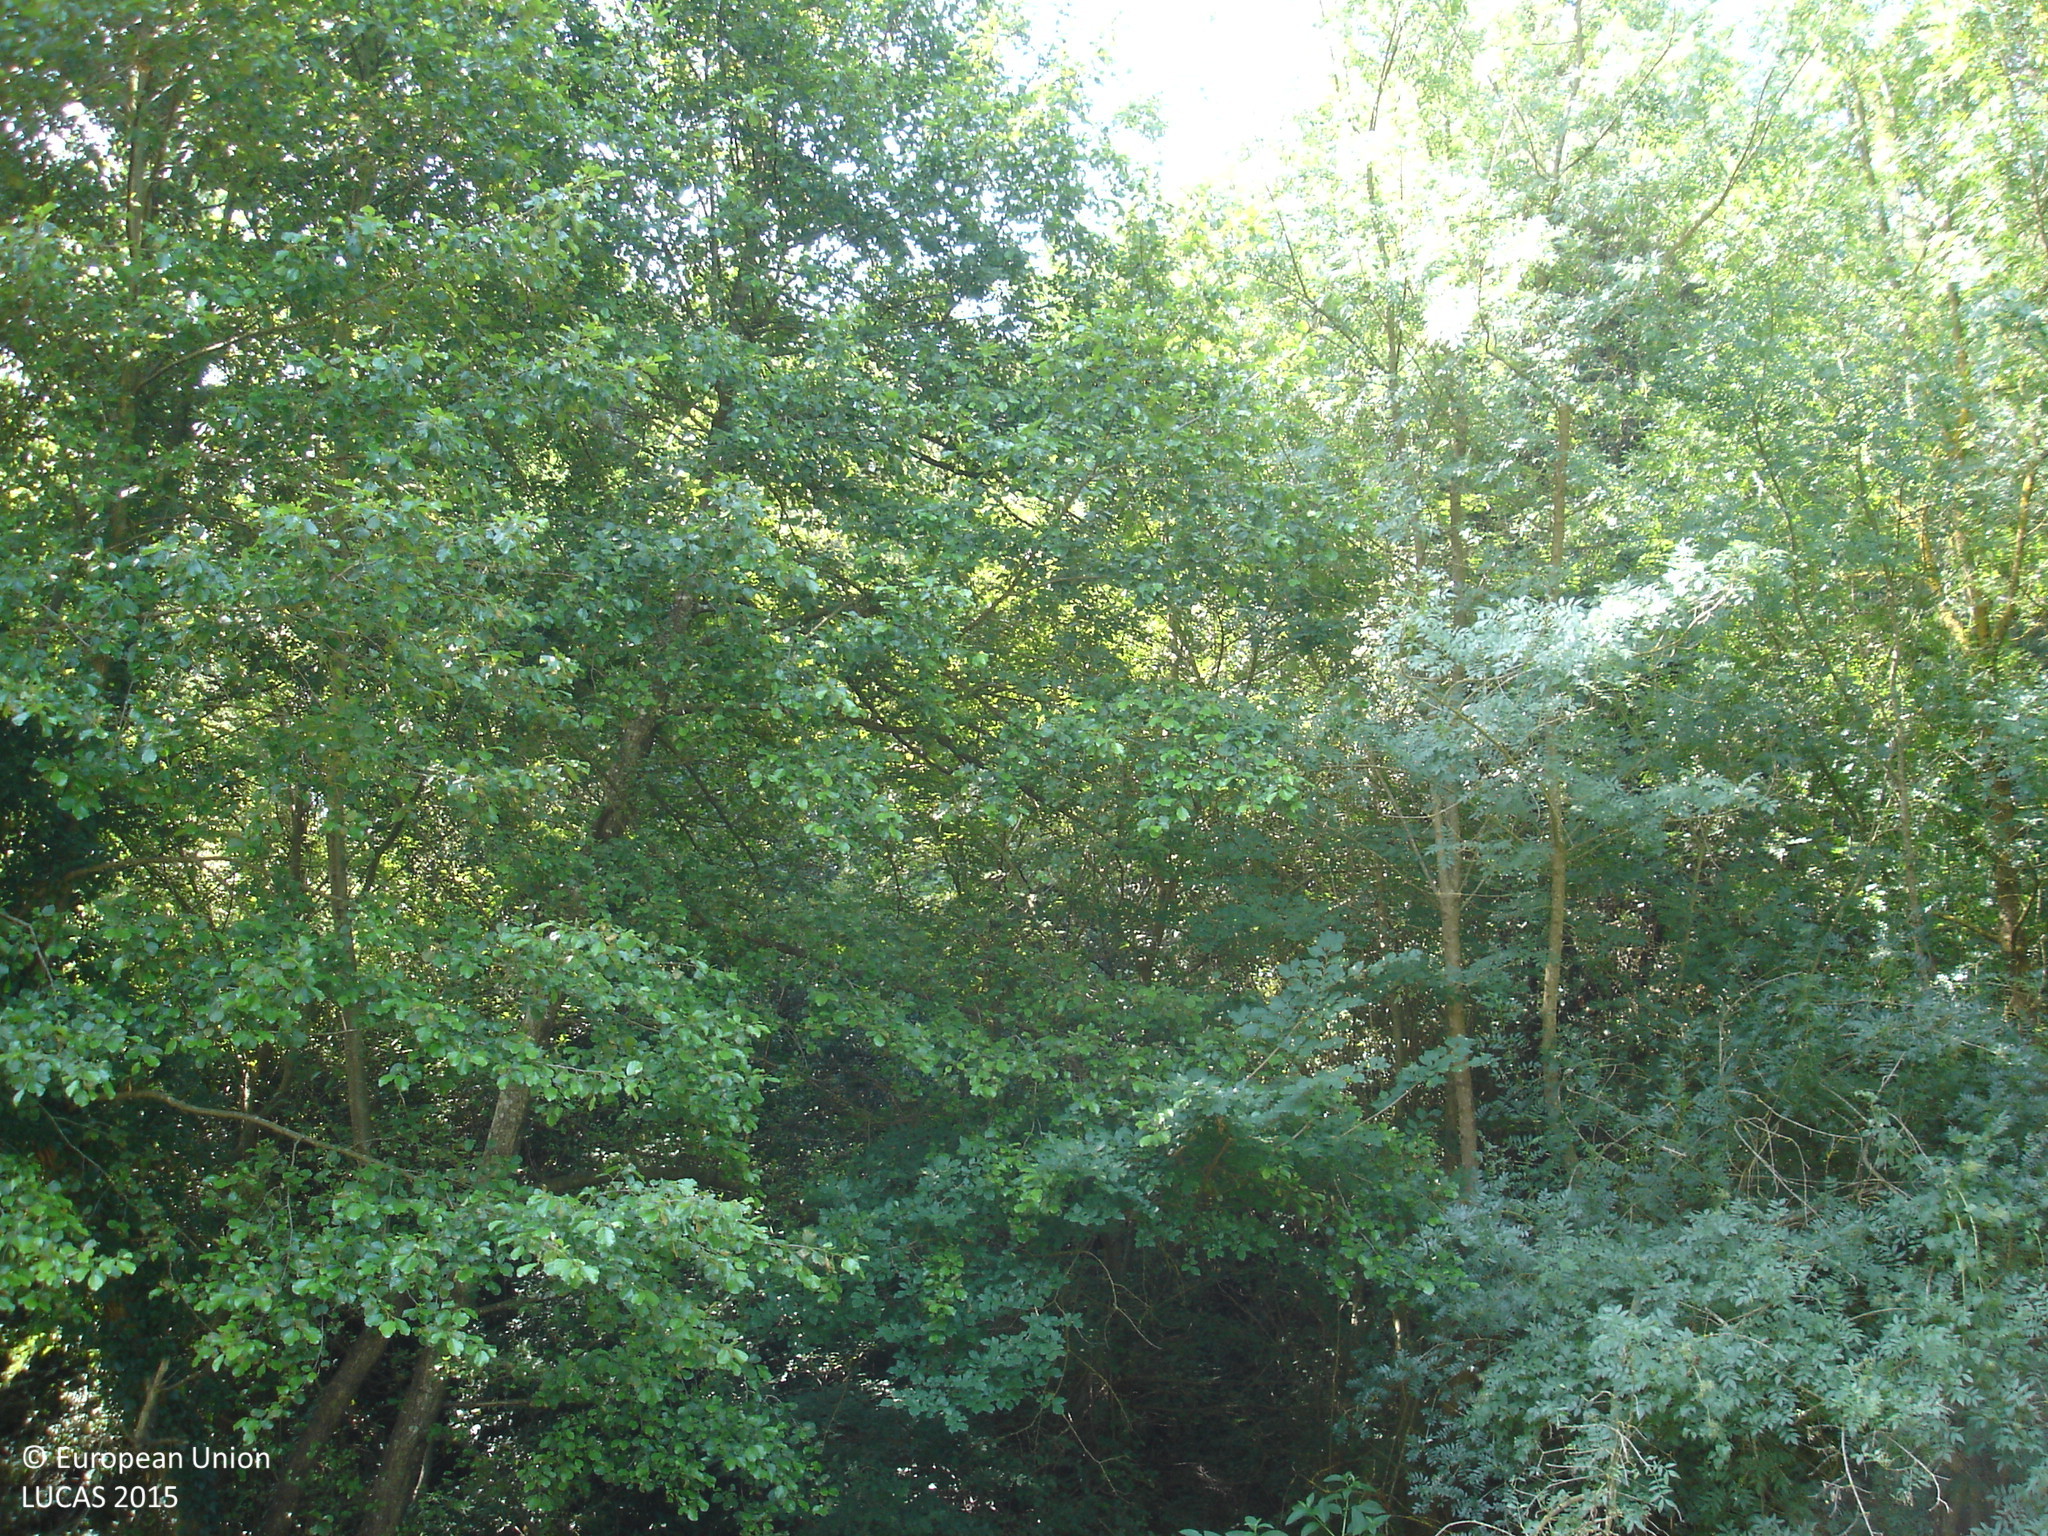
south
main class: Grassland
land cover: Grassland with sparse tree/shrub cover
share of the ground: > 75 %
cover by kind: herbaceous plants 90 %, broadleaved forest trees 5 %, consolidated bare surface 5 %
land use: Semi-natural and natural areas not in use
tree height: > 5 m
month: July
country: ES
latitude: 41.9949
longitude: 3.0020
